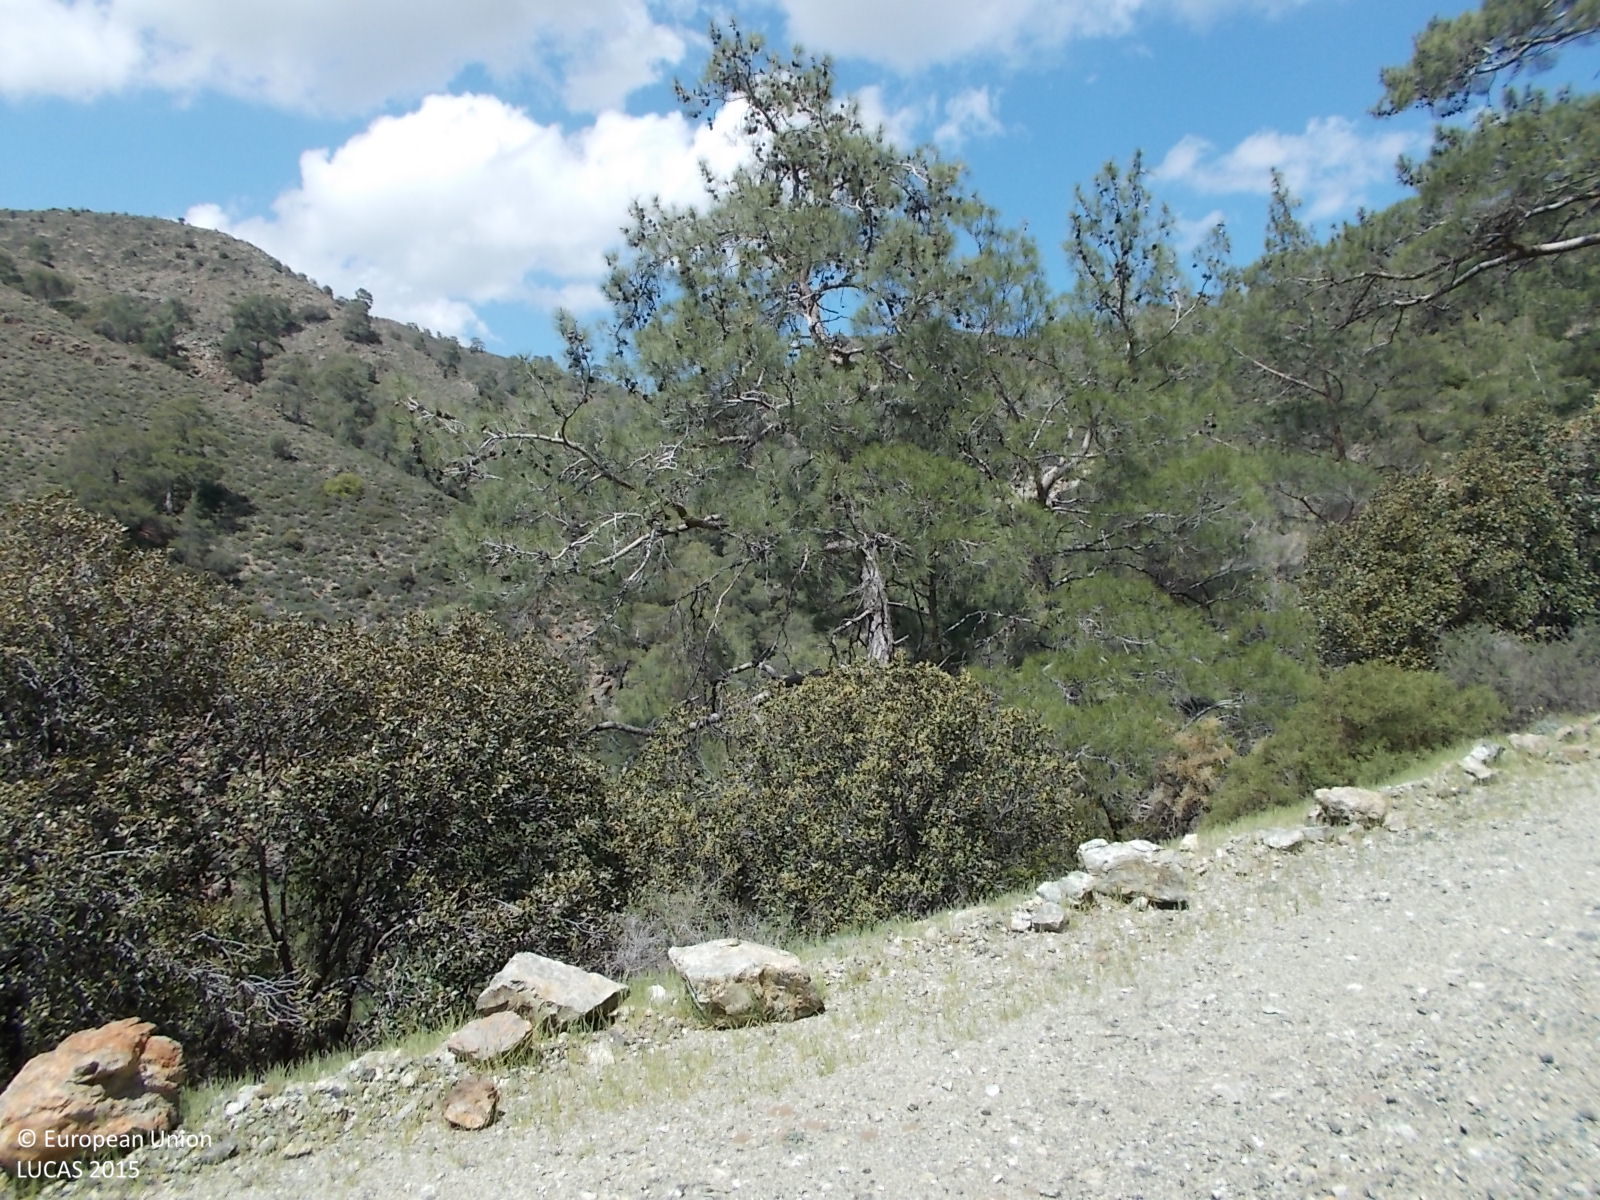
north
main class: Woodland
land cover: Pine dominated coniferous woodland
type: coniferous forest of the mediterranean region
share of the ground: 10 - 25 %
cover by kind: shrubs 50 %, coniferous forest trees 20 %, unconsolidated bare surface 20 %, consolidated bare surface 10 %
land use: Forestry
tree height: > 5 m
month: April
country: CY
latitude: 34.8128
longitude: 33.0728
